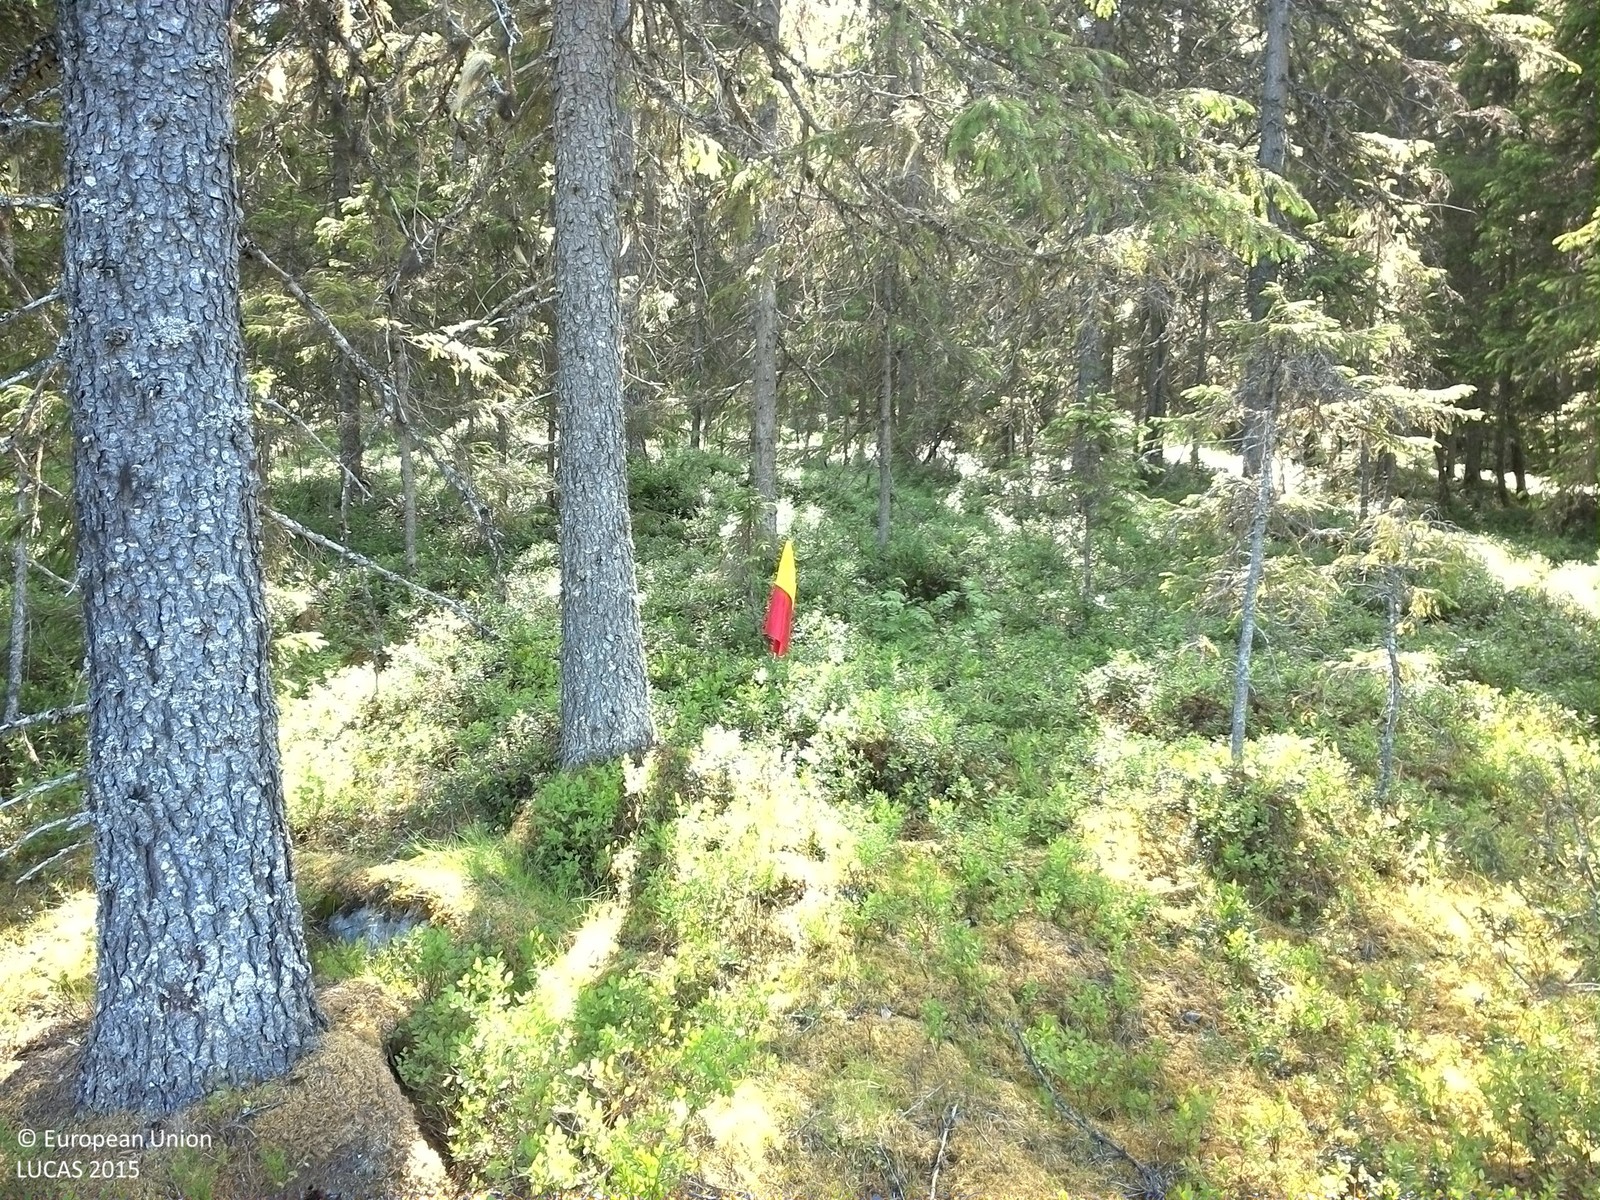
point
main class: Woodland
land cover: Spruce dominated coniferous woodland
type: boreal forest
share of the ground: > 75 %
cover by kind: coniferous forest trees 75 %, shrubs 20 %, herbaceous plants 5 %
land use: Forestry
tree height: > 5 m
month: July
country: SE
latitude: 64.5626
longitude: 15.8323
